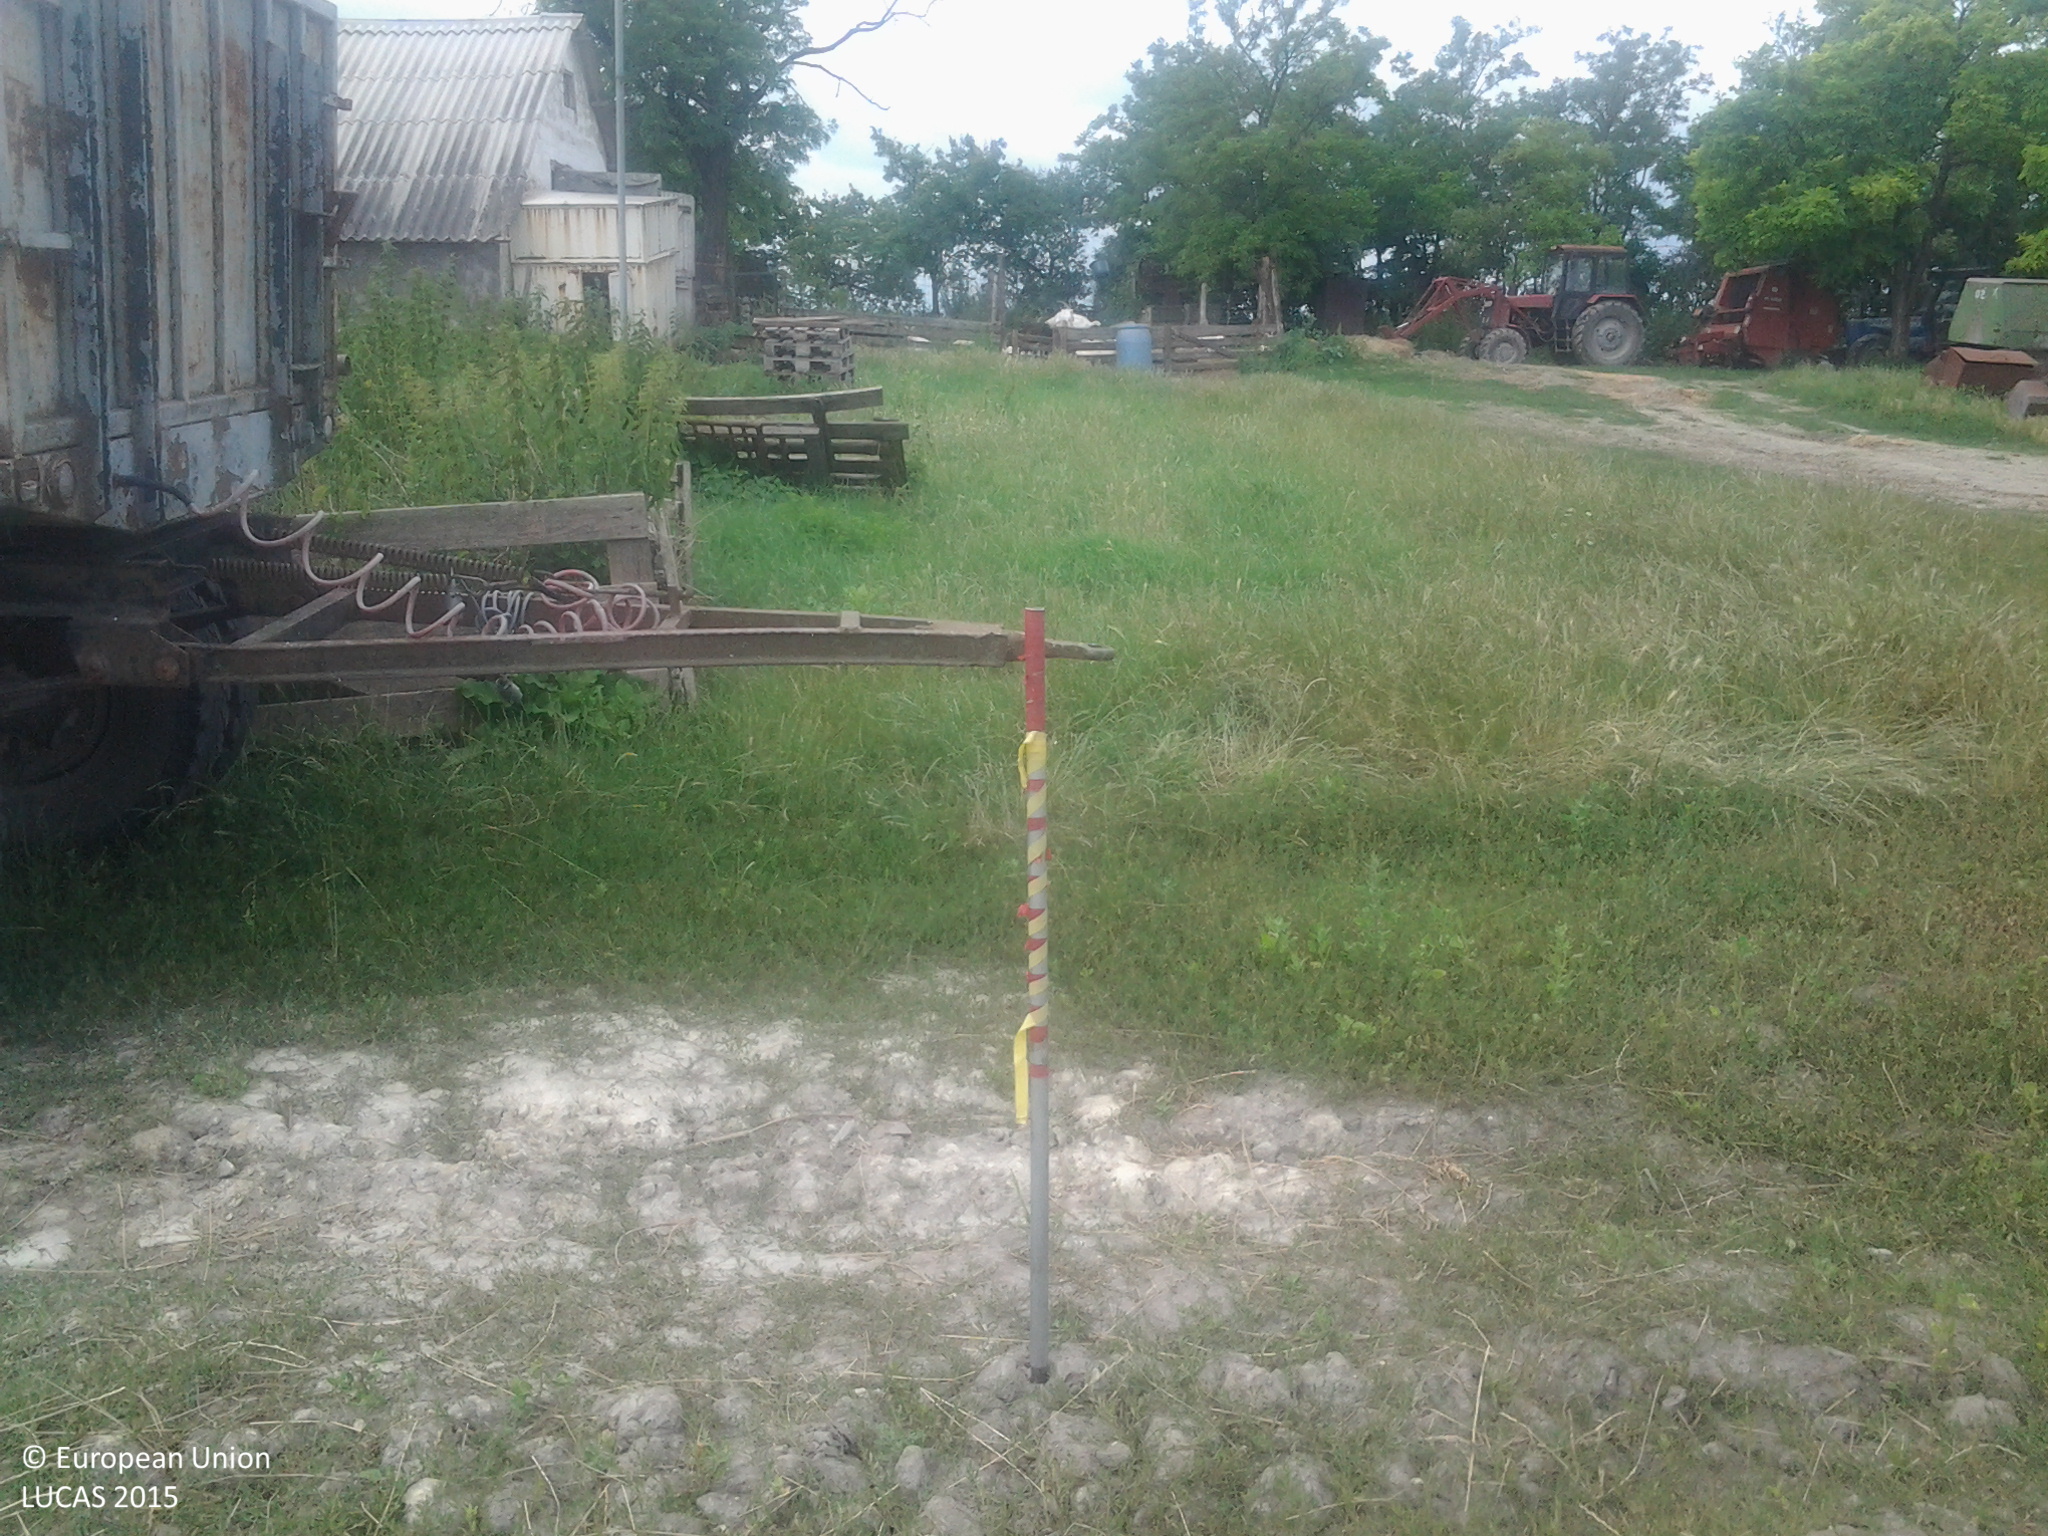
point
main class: Grassland
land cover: Grassland without tree/shrub cover
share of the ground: > 75 %
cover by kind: herbaceous plants 100 %
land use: Agriculture (excluding fallow land and kitchen gardens)
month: June
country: HU
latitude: 46.9929
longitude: 19.1290
